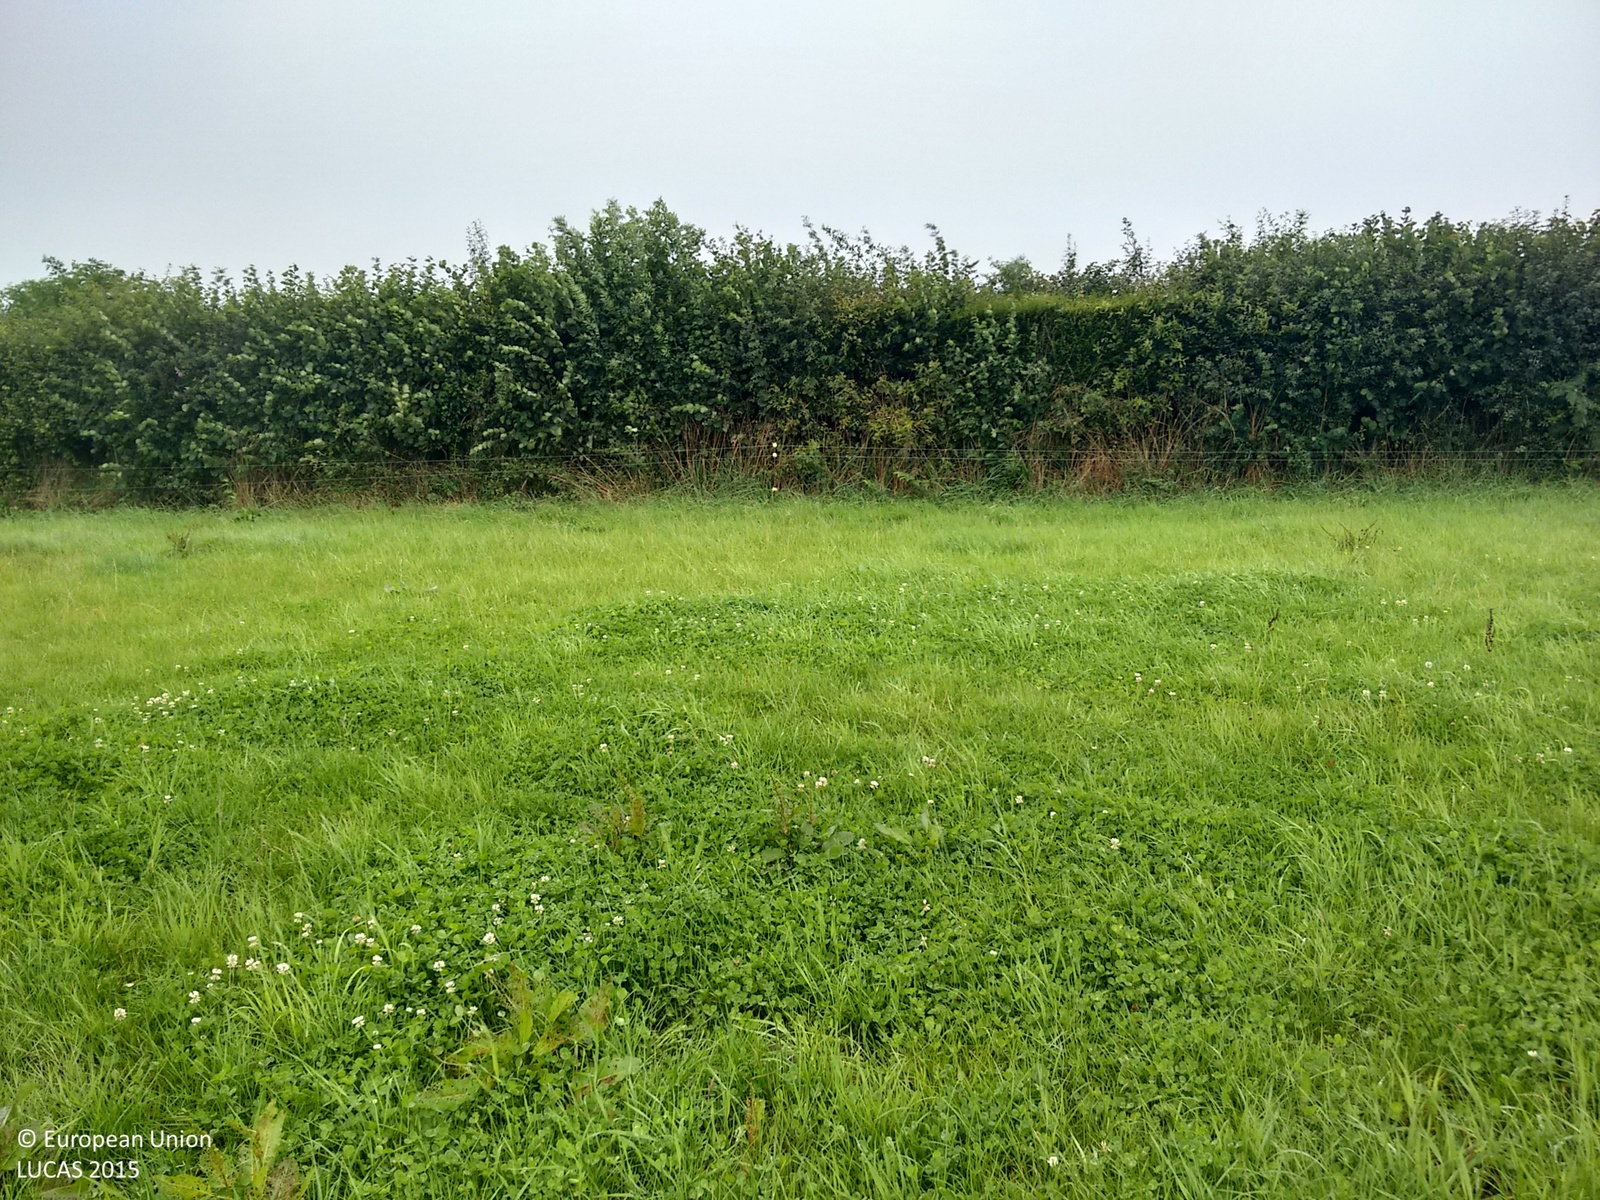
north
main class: Grassland
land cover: Grassland without tree/shrub cover
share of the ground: > 75 %
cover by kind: herbaceous plants 100 %
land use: Agriculture (excluding fallow land and kitchen gardens)
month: August
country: GB
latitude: 50.8858
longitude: -3.6914
